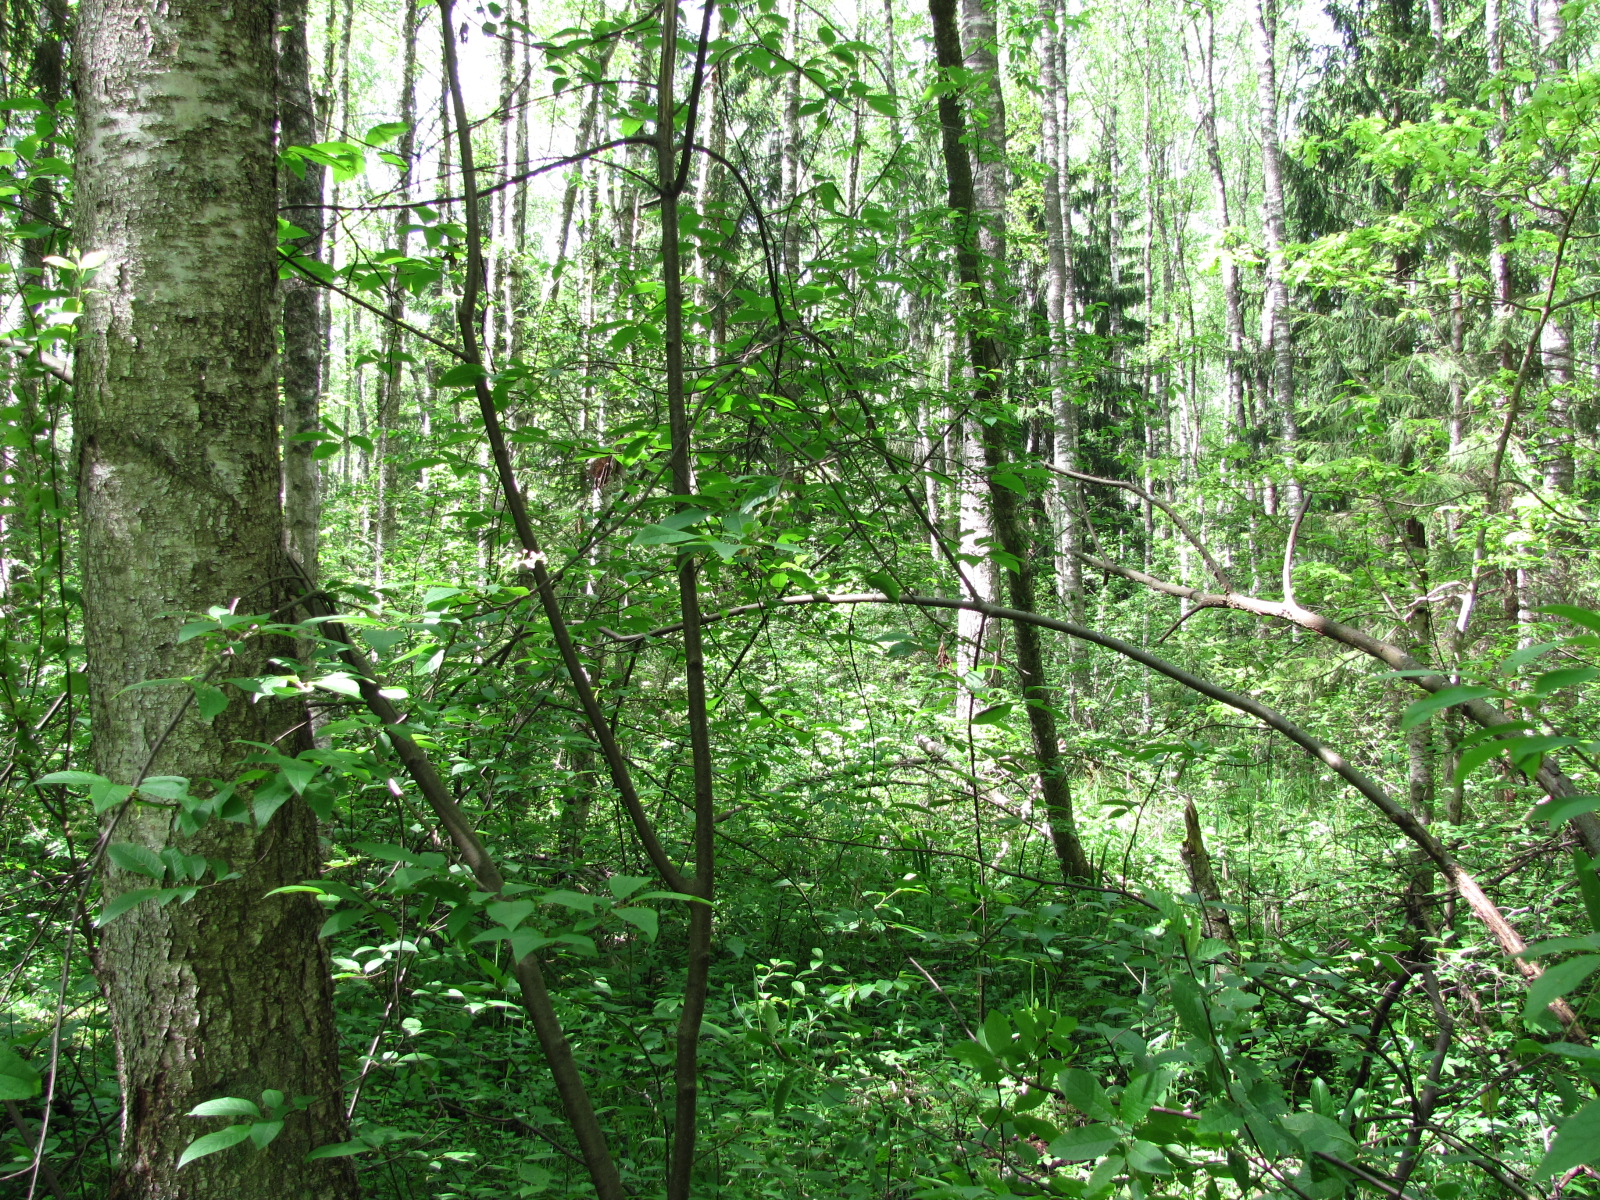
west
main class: Woodland
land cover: Spruce dominated mixed woodland
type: hemiboreal forest and nemoral coniferous forest and mixed broadleaved-coniferous forest
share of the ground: > 75 %
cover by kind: coniferous forest trees 70 %, broadleaved forest trees 30 %
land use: Forestry
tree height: > 5 m
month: May
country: LV
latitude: 56.6549
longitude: 24.0318
